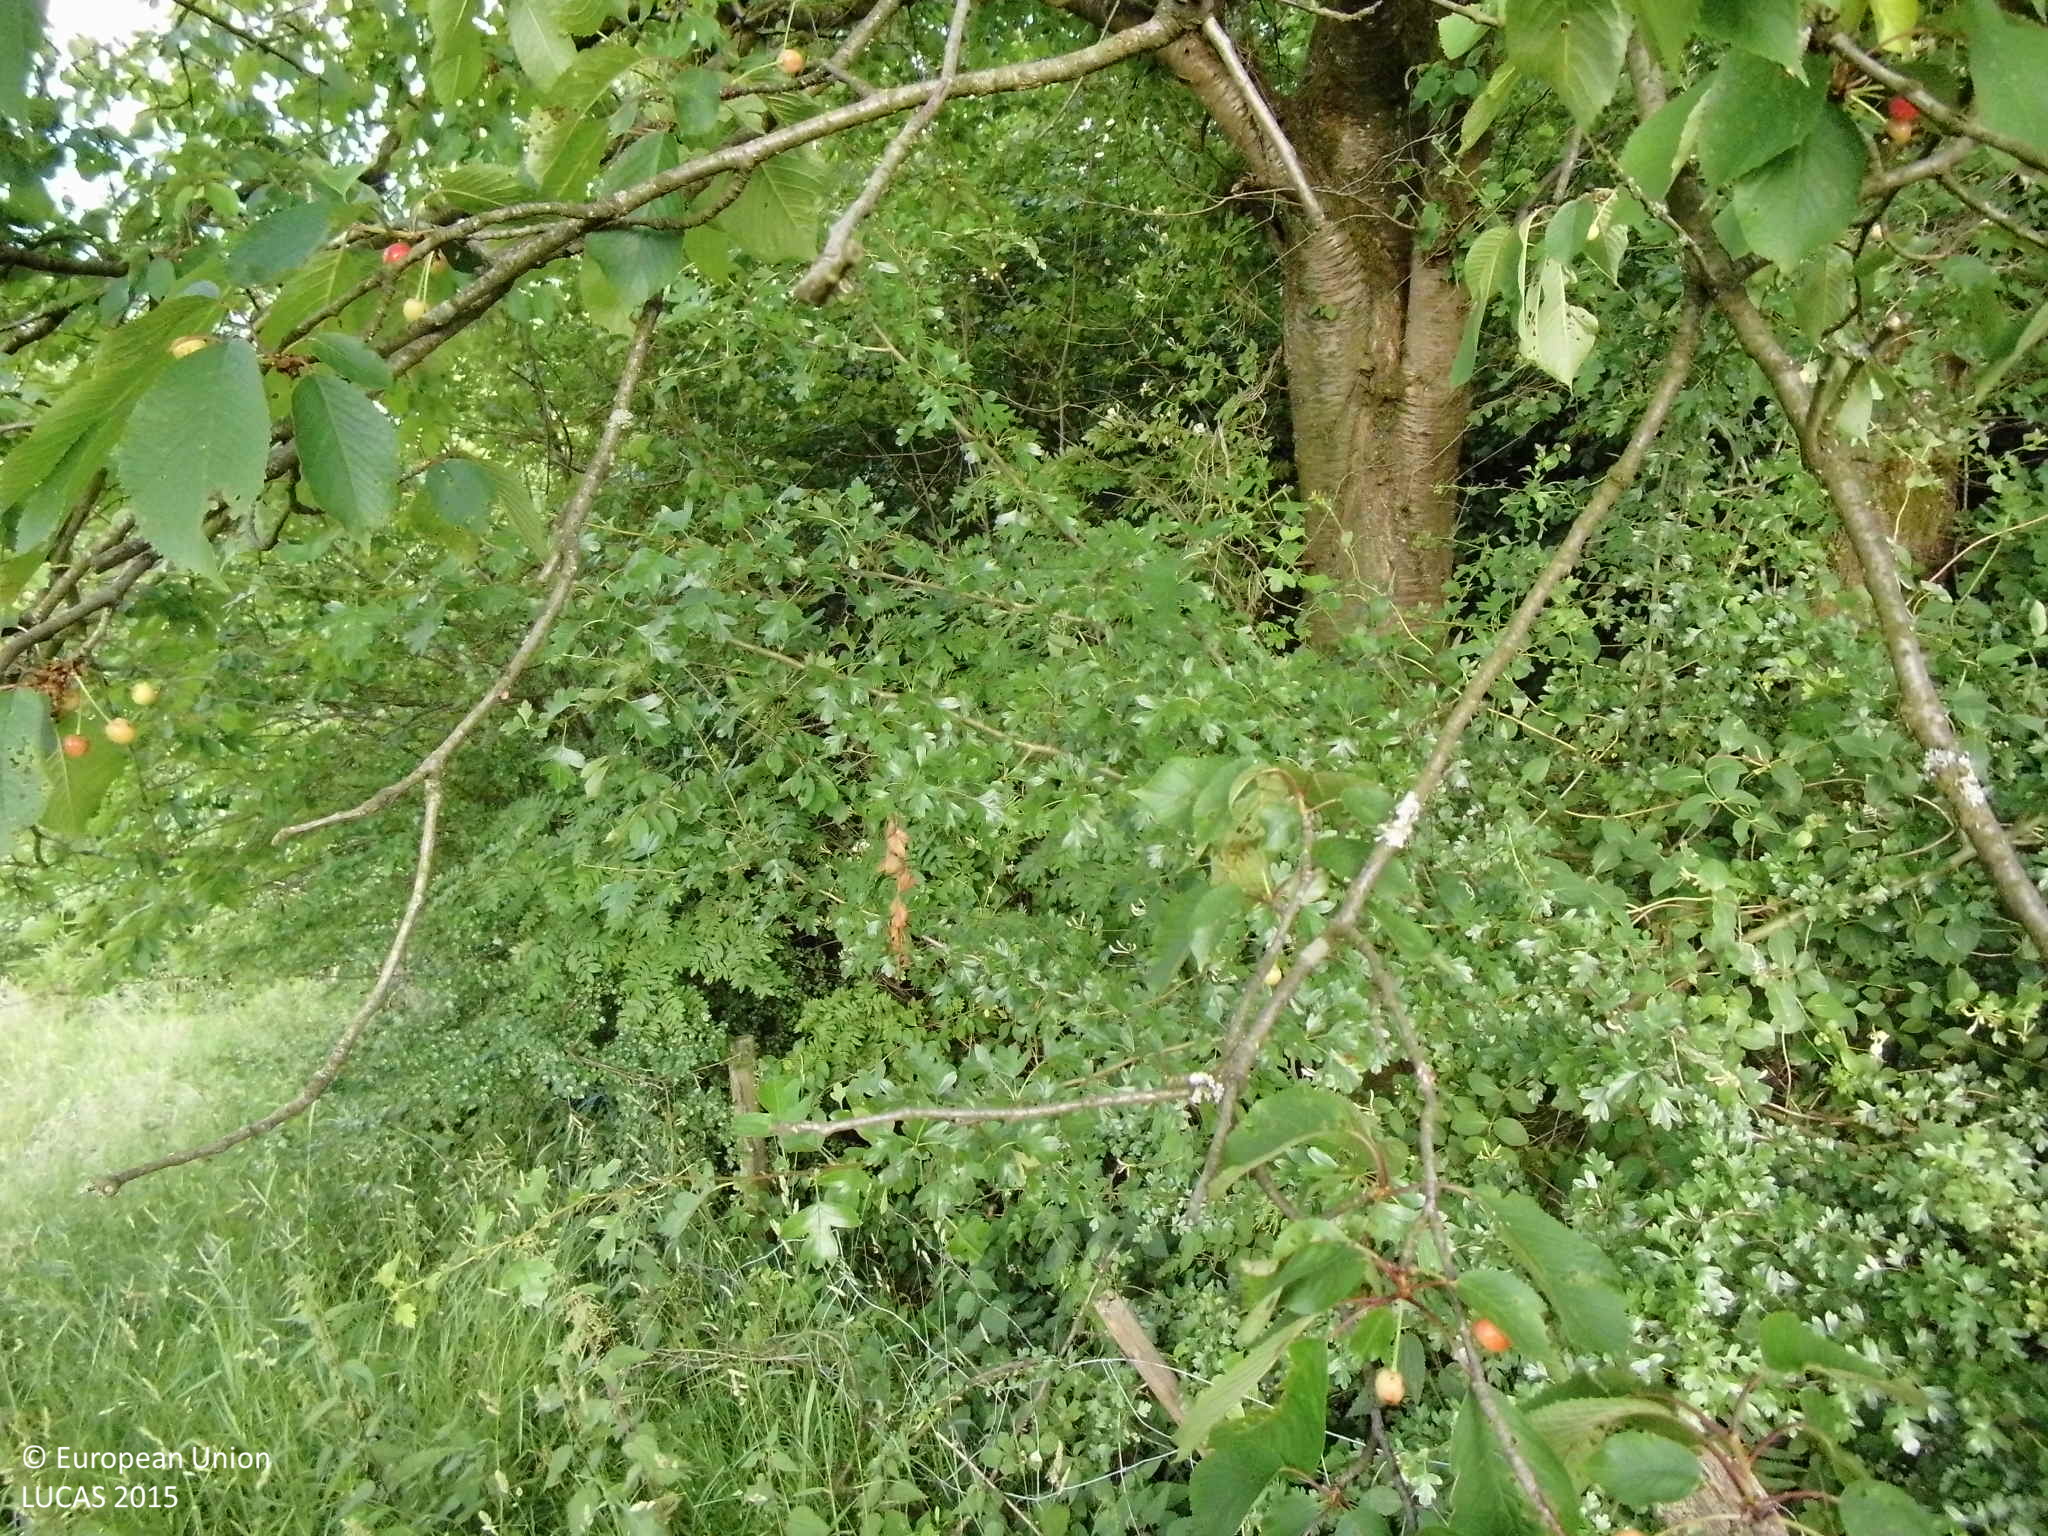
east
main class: Grassland
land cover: Grassland without tree/shrub cover
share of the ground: > 75 %
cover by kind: herbaceous plants 100 %
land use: Agriculture (excluding fallow land and kitchen gardens)
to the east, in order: Grassland without tree/shrub cover; Fences; Broadleaved woodland; Electric lines; Paved roads, cycling and walking lanes; Fences; Grassland without tree/shrub cover; Fences; Rivers and streams; Fences; Grassland without tree/shrub cover; Fences; Grassland without tree/shrub cover
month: June
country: DE
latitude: 50.8773
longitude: 7.5415
